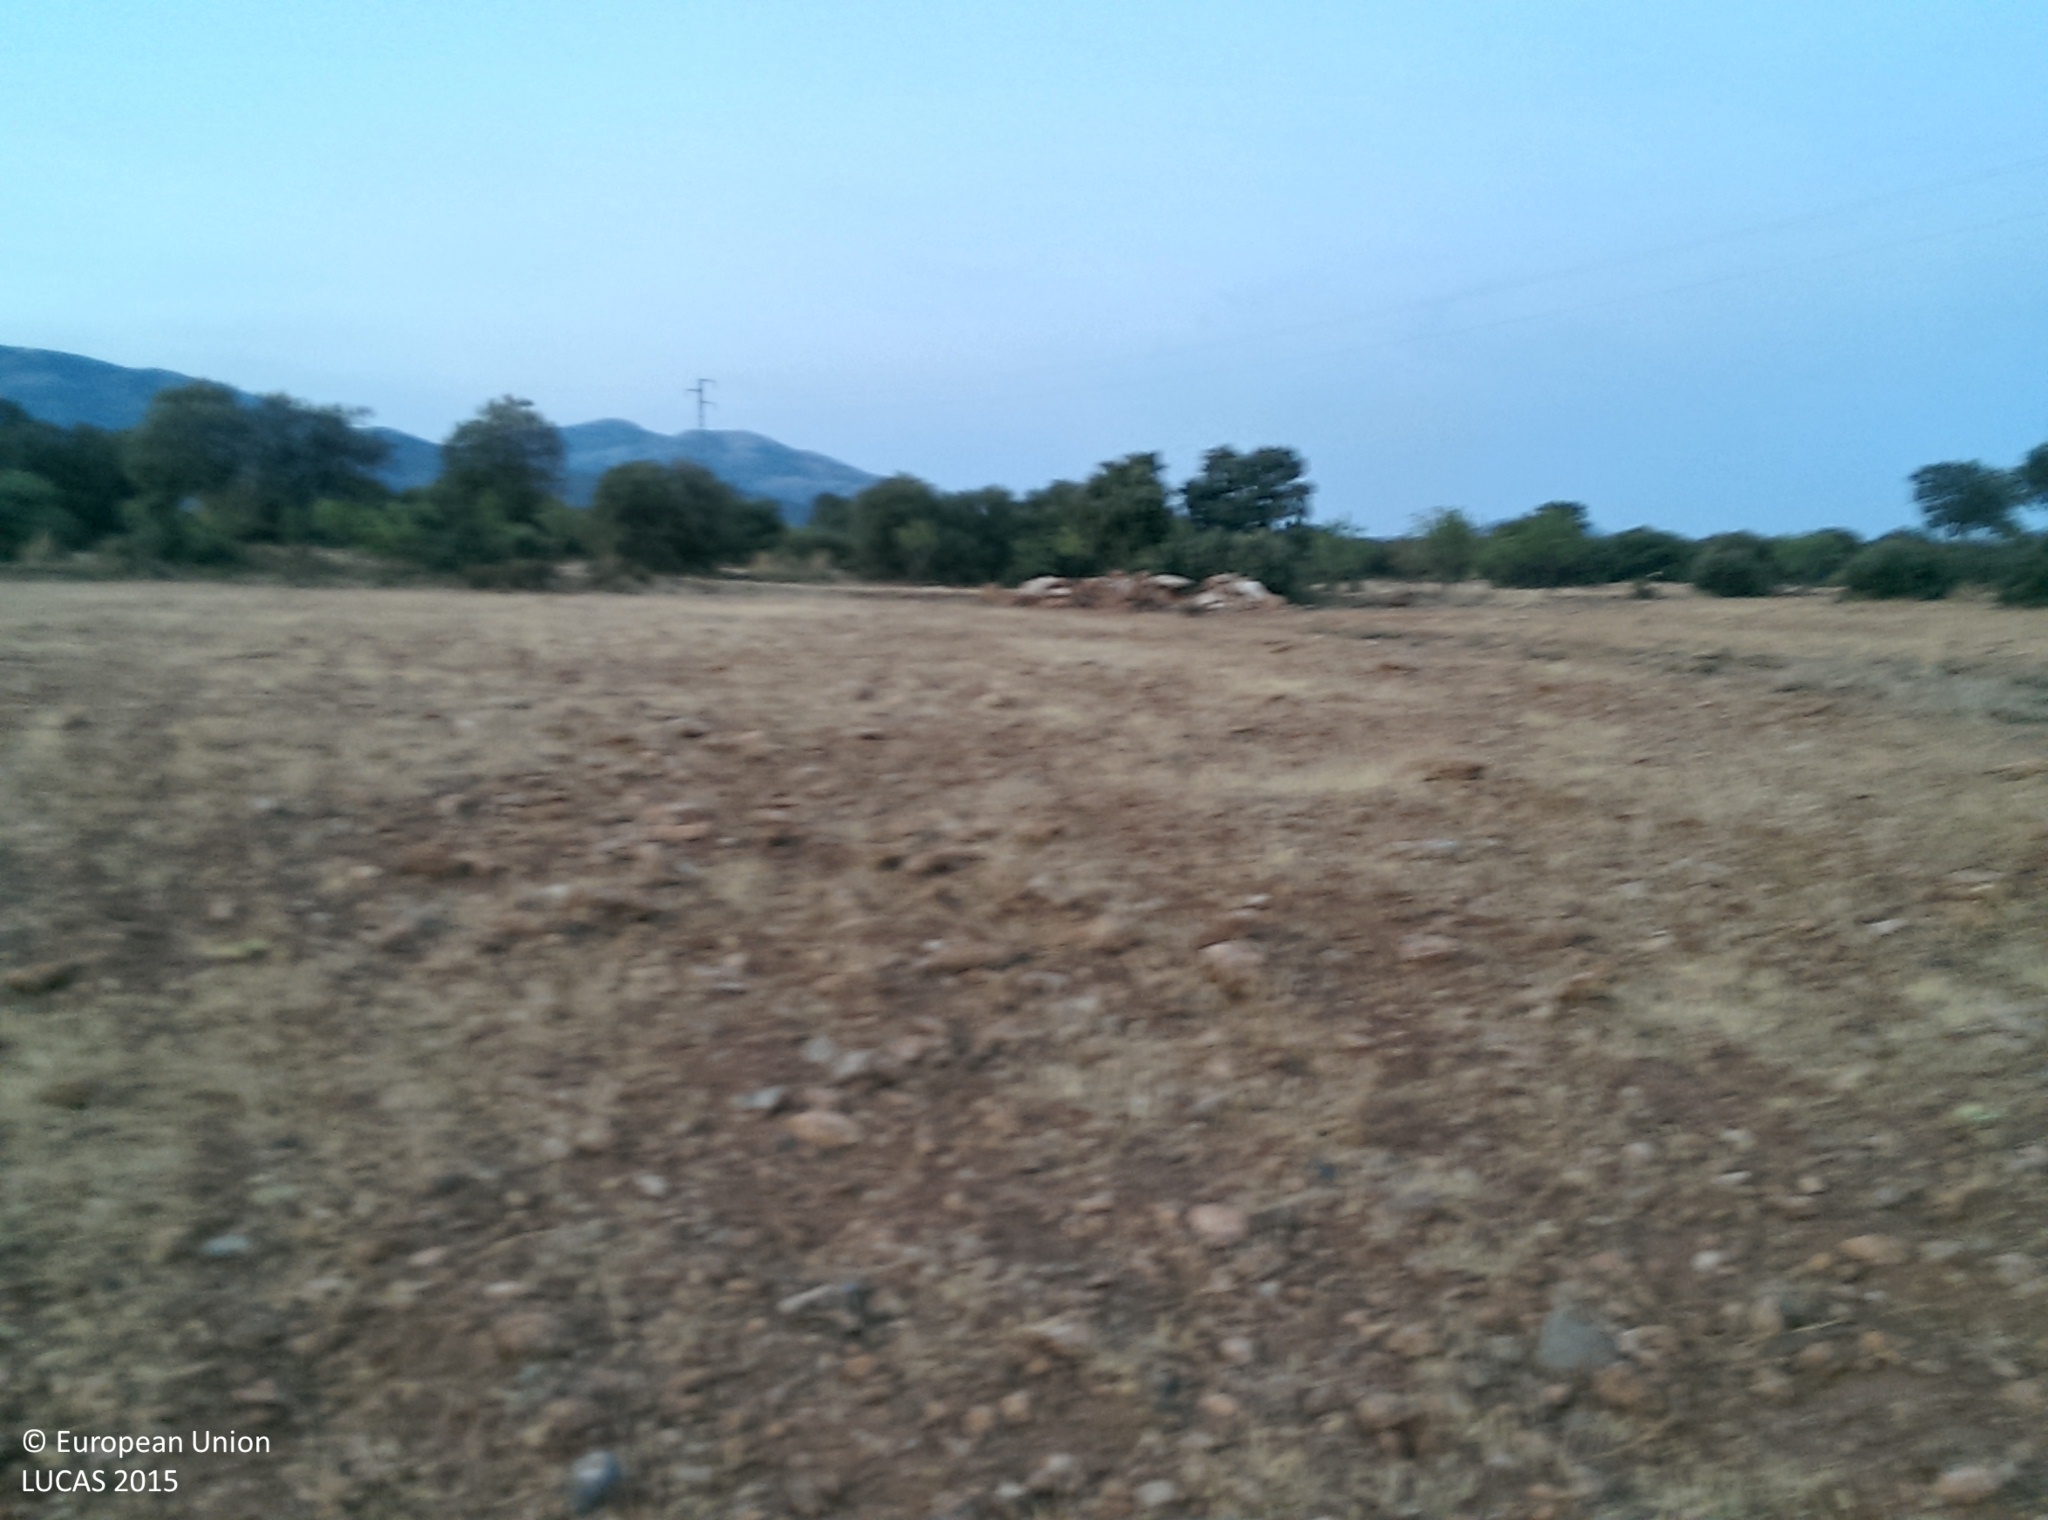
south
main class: Grassland
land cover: Spontaneously vegetated surfaces
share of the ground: 10 - 25 %
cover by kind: unconsolidated bare surface 80 %, herbaceous plants 20 %
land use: Agriculture (excluding fallow land and kitchen gardens)
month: July
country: ES
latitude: 37.4686
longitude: -2.9115
